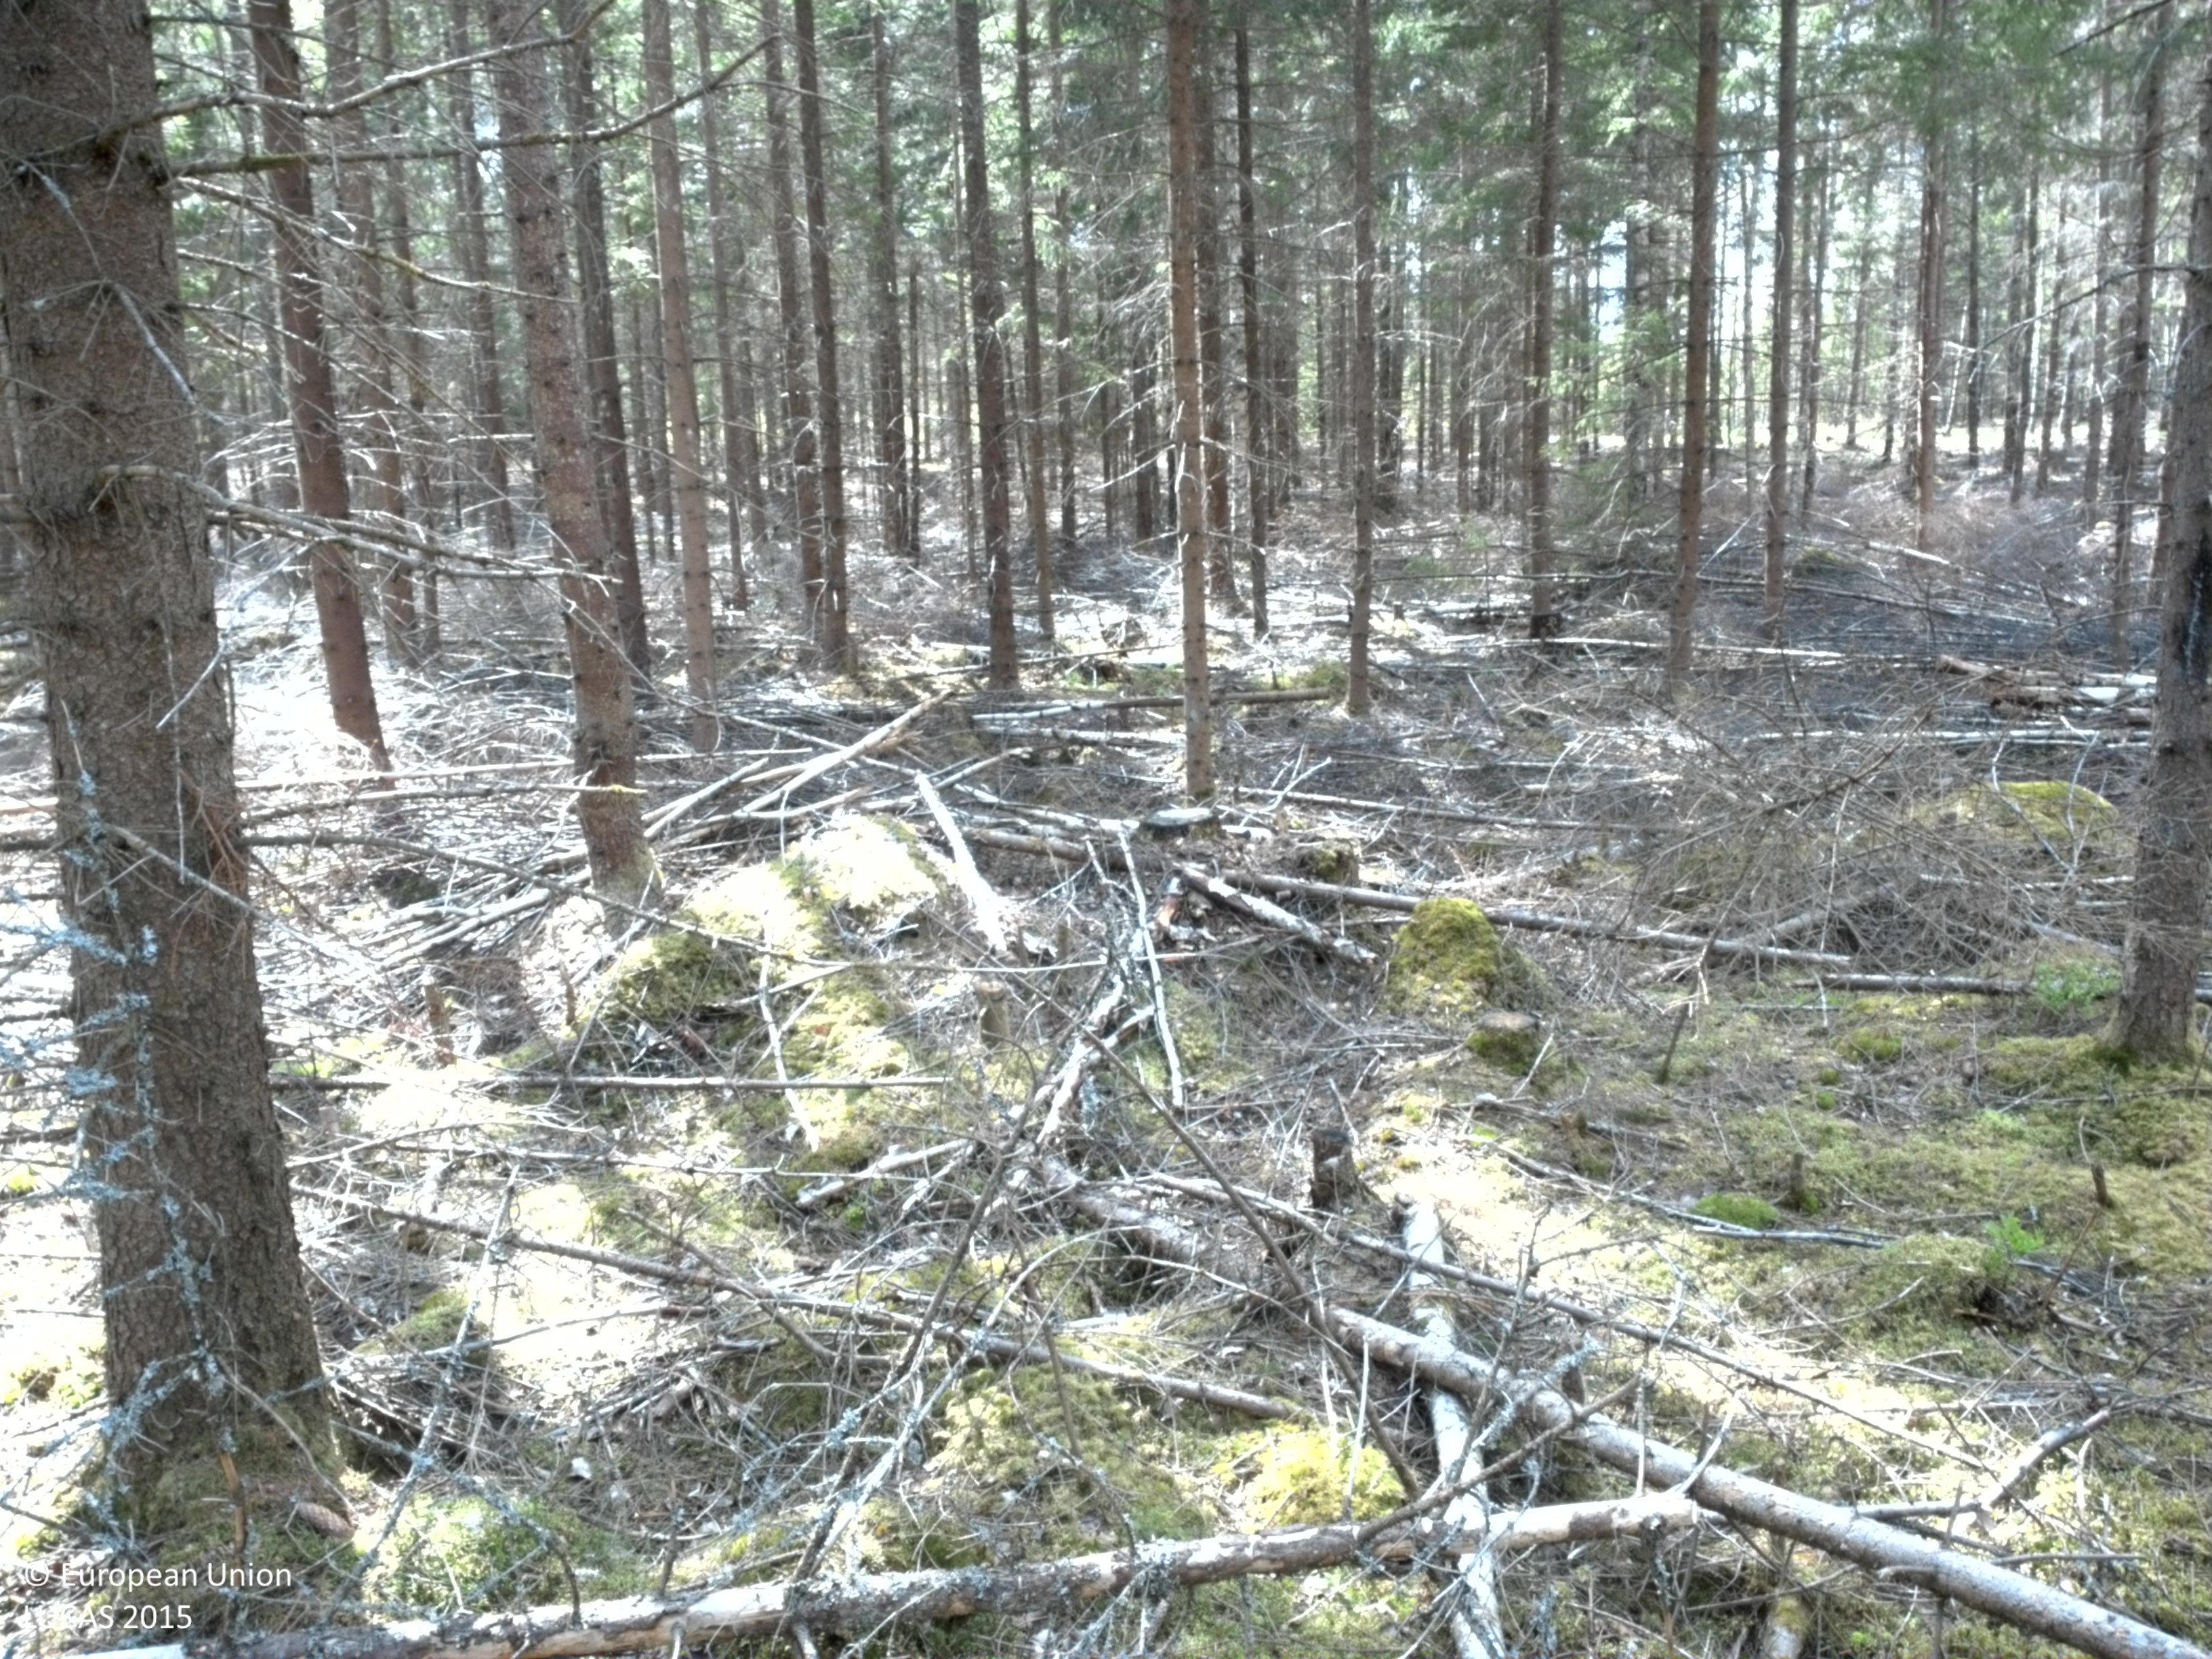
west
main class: Woodland
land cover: Spruce dominated coniferous woodland
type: boreal forest
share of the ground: > 75 %
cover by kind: coniferous forest trees 80 %, lichens and mosses 15 %, broadleaved forest trees 5 %
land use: Forestry
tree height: > 5 m
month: May
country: SE
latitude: 56.5986
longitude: 15.3572
